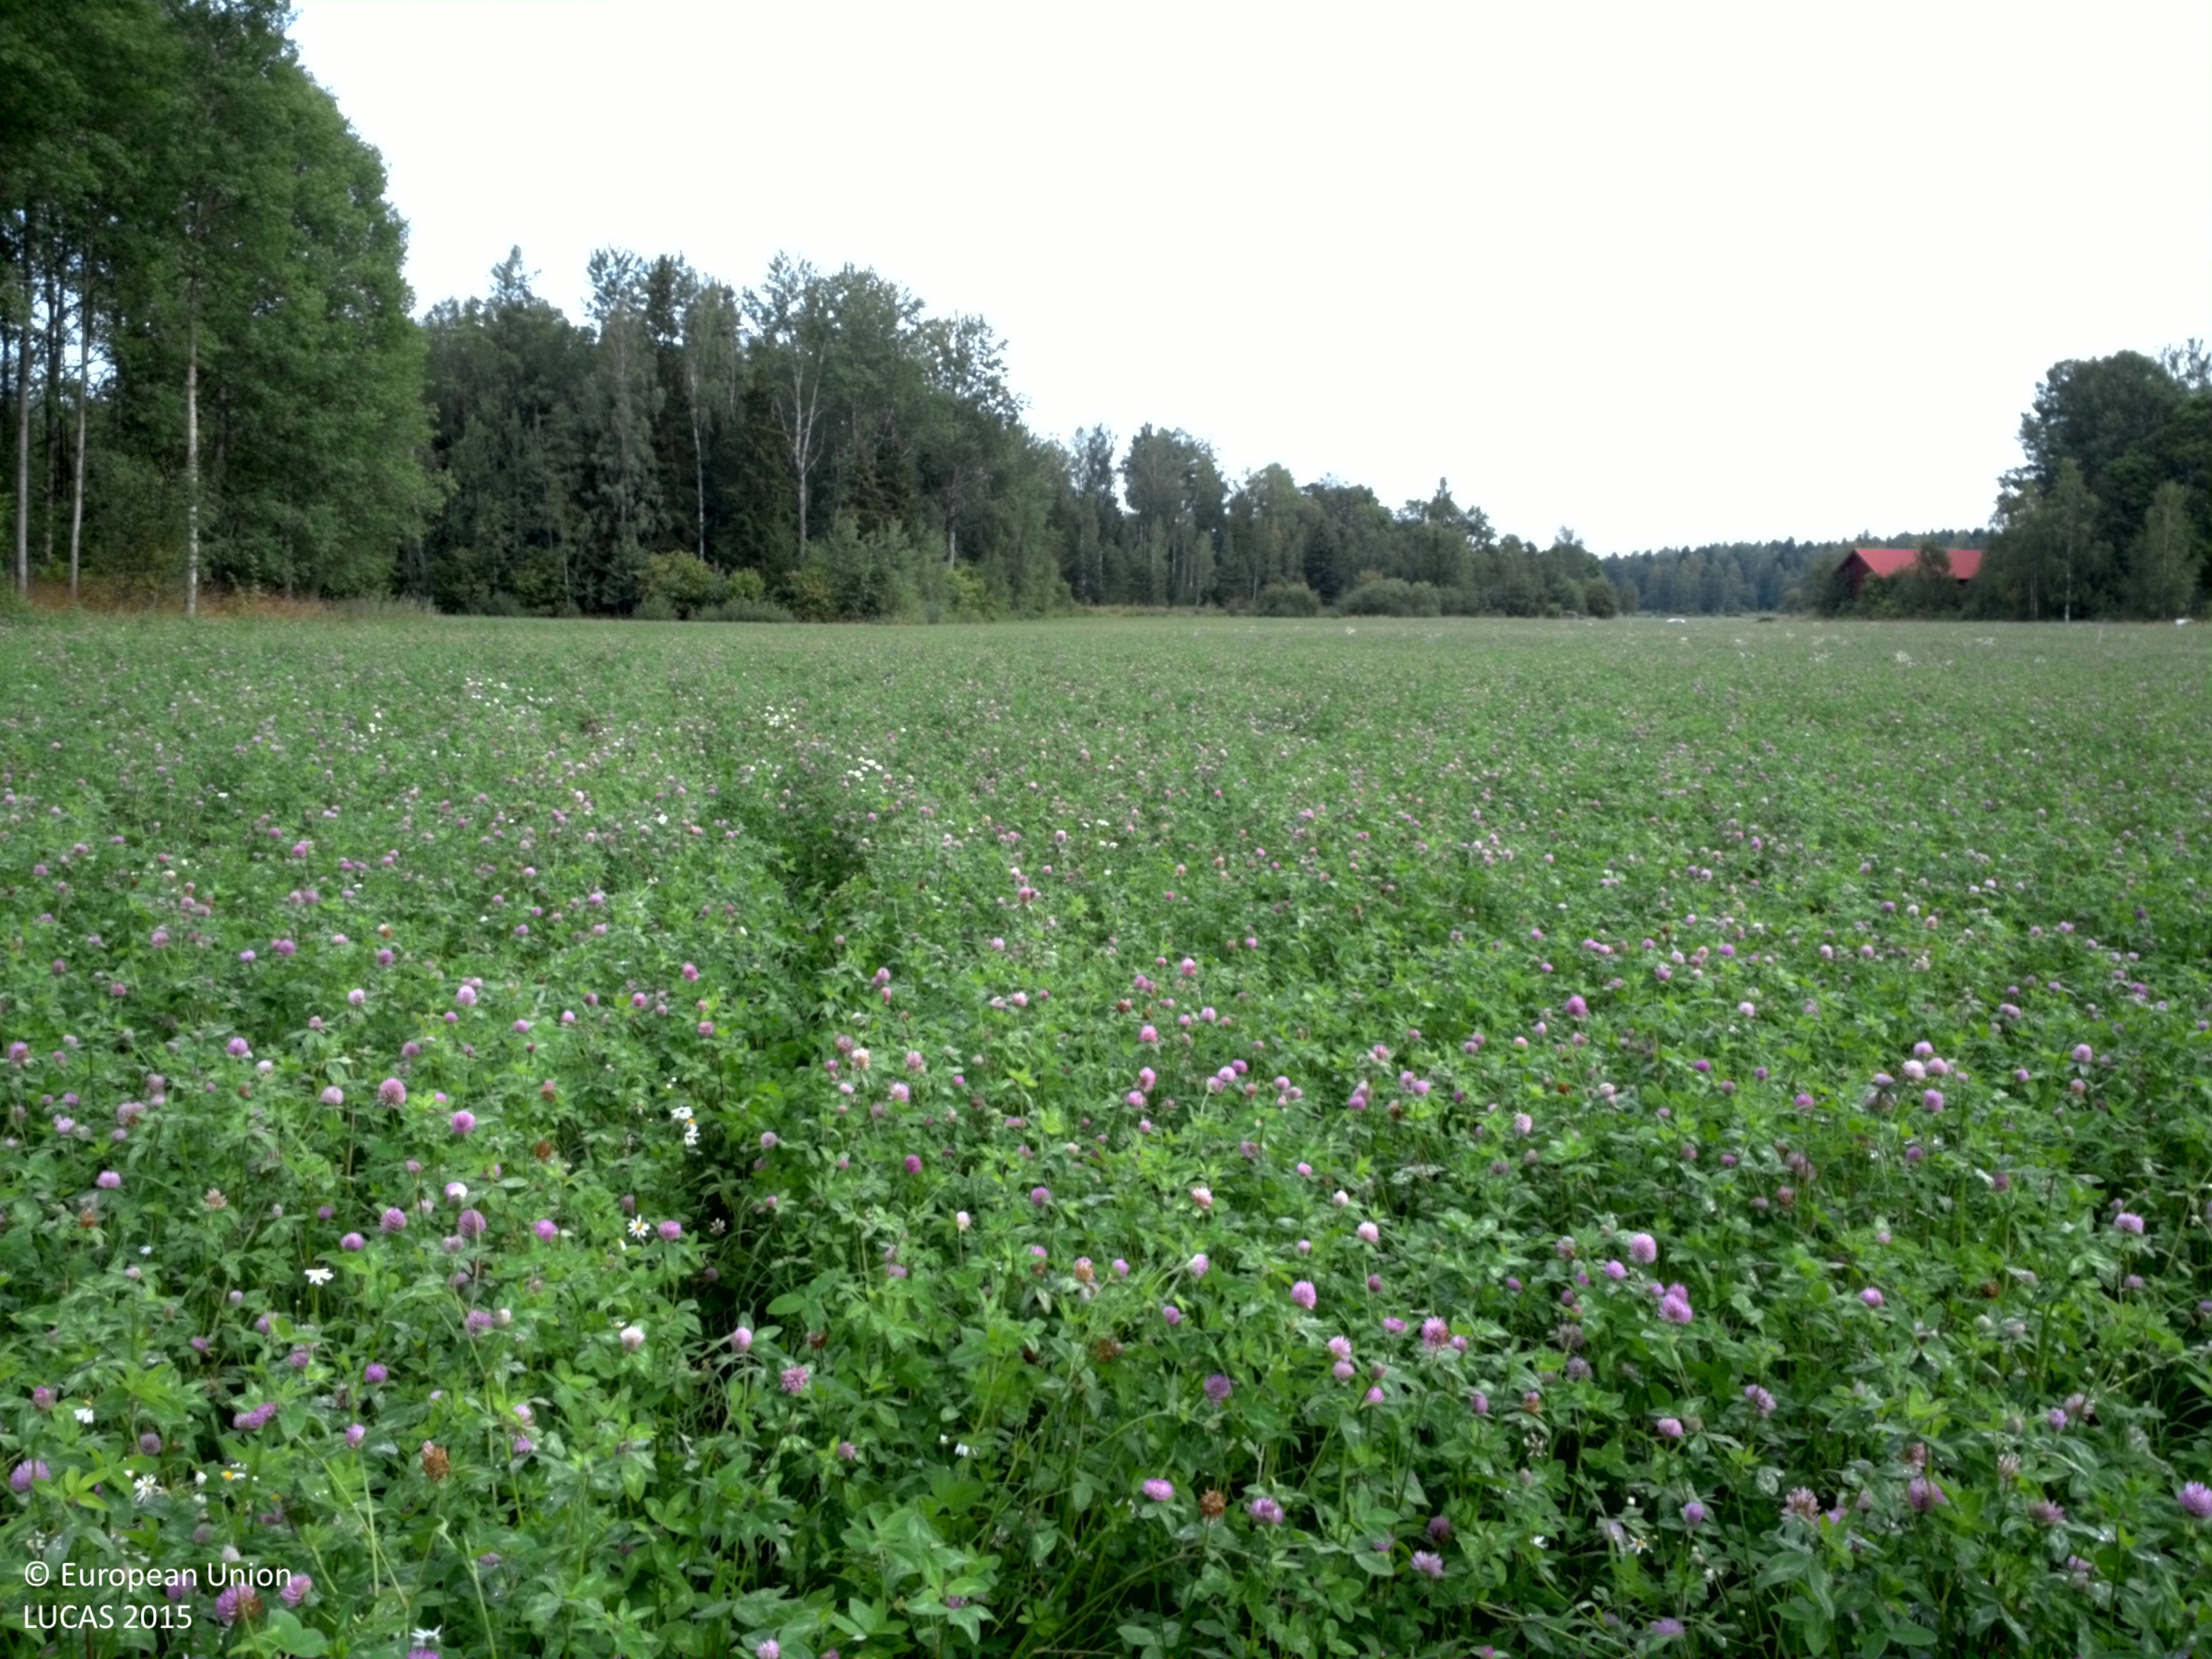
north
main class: Cropland
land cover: Clovers
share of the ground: > 75 %
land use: Agriculture (excluding fallow land and kitchen gardens)
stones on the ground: < 10 %
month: August
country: SE
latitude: 59.9264
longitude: 16.4134
